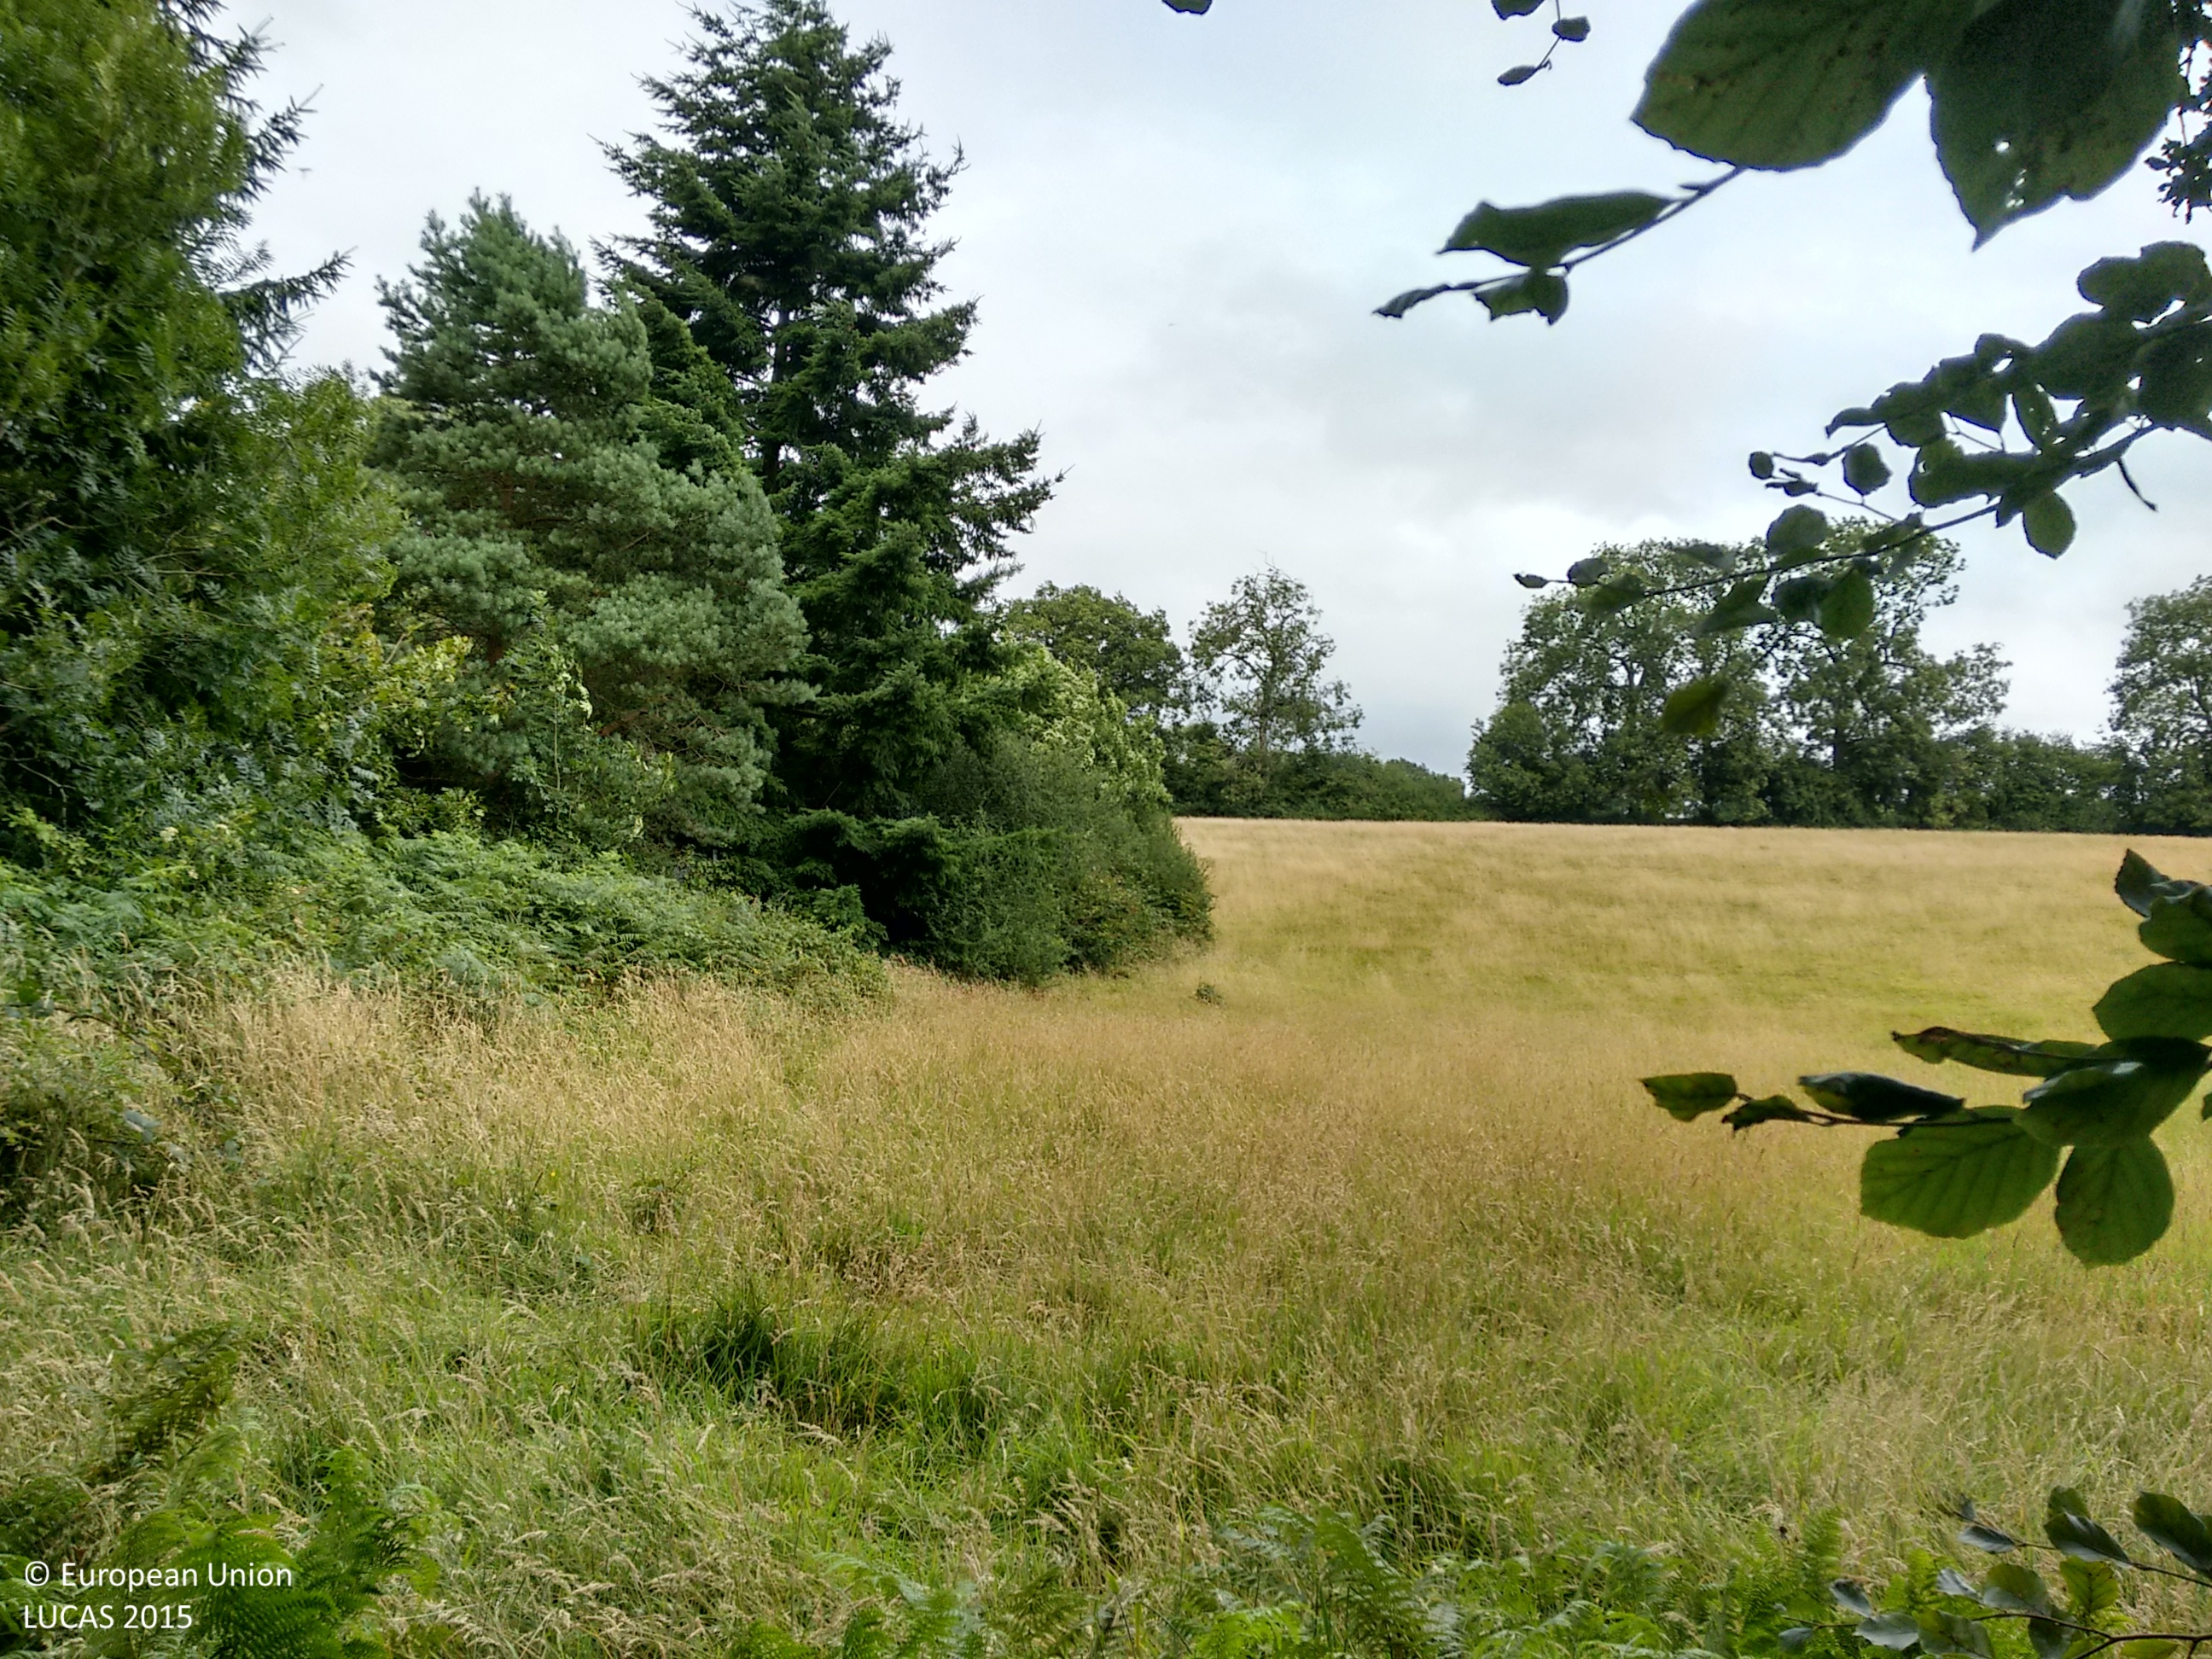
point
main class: Woodland
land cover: Broadleaved woodland
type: mesophytic deciduous forest
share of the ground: > 75 %
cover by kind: broadleaved forest trees 75 %, shrubs 25 %
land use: Forestry
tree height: > 5 m
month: August
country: GB
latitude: 51.2741
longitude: -0.1112
